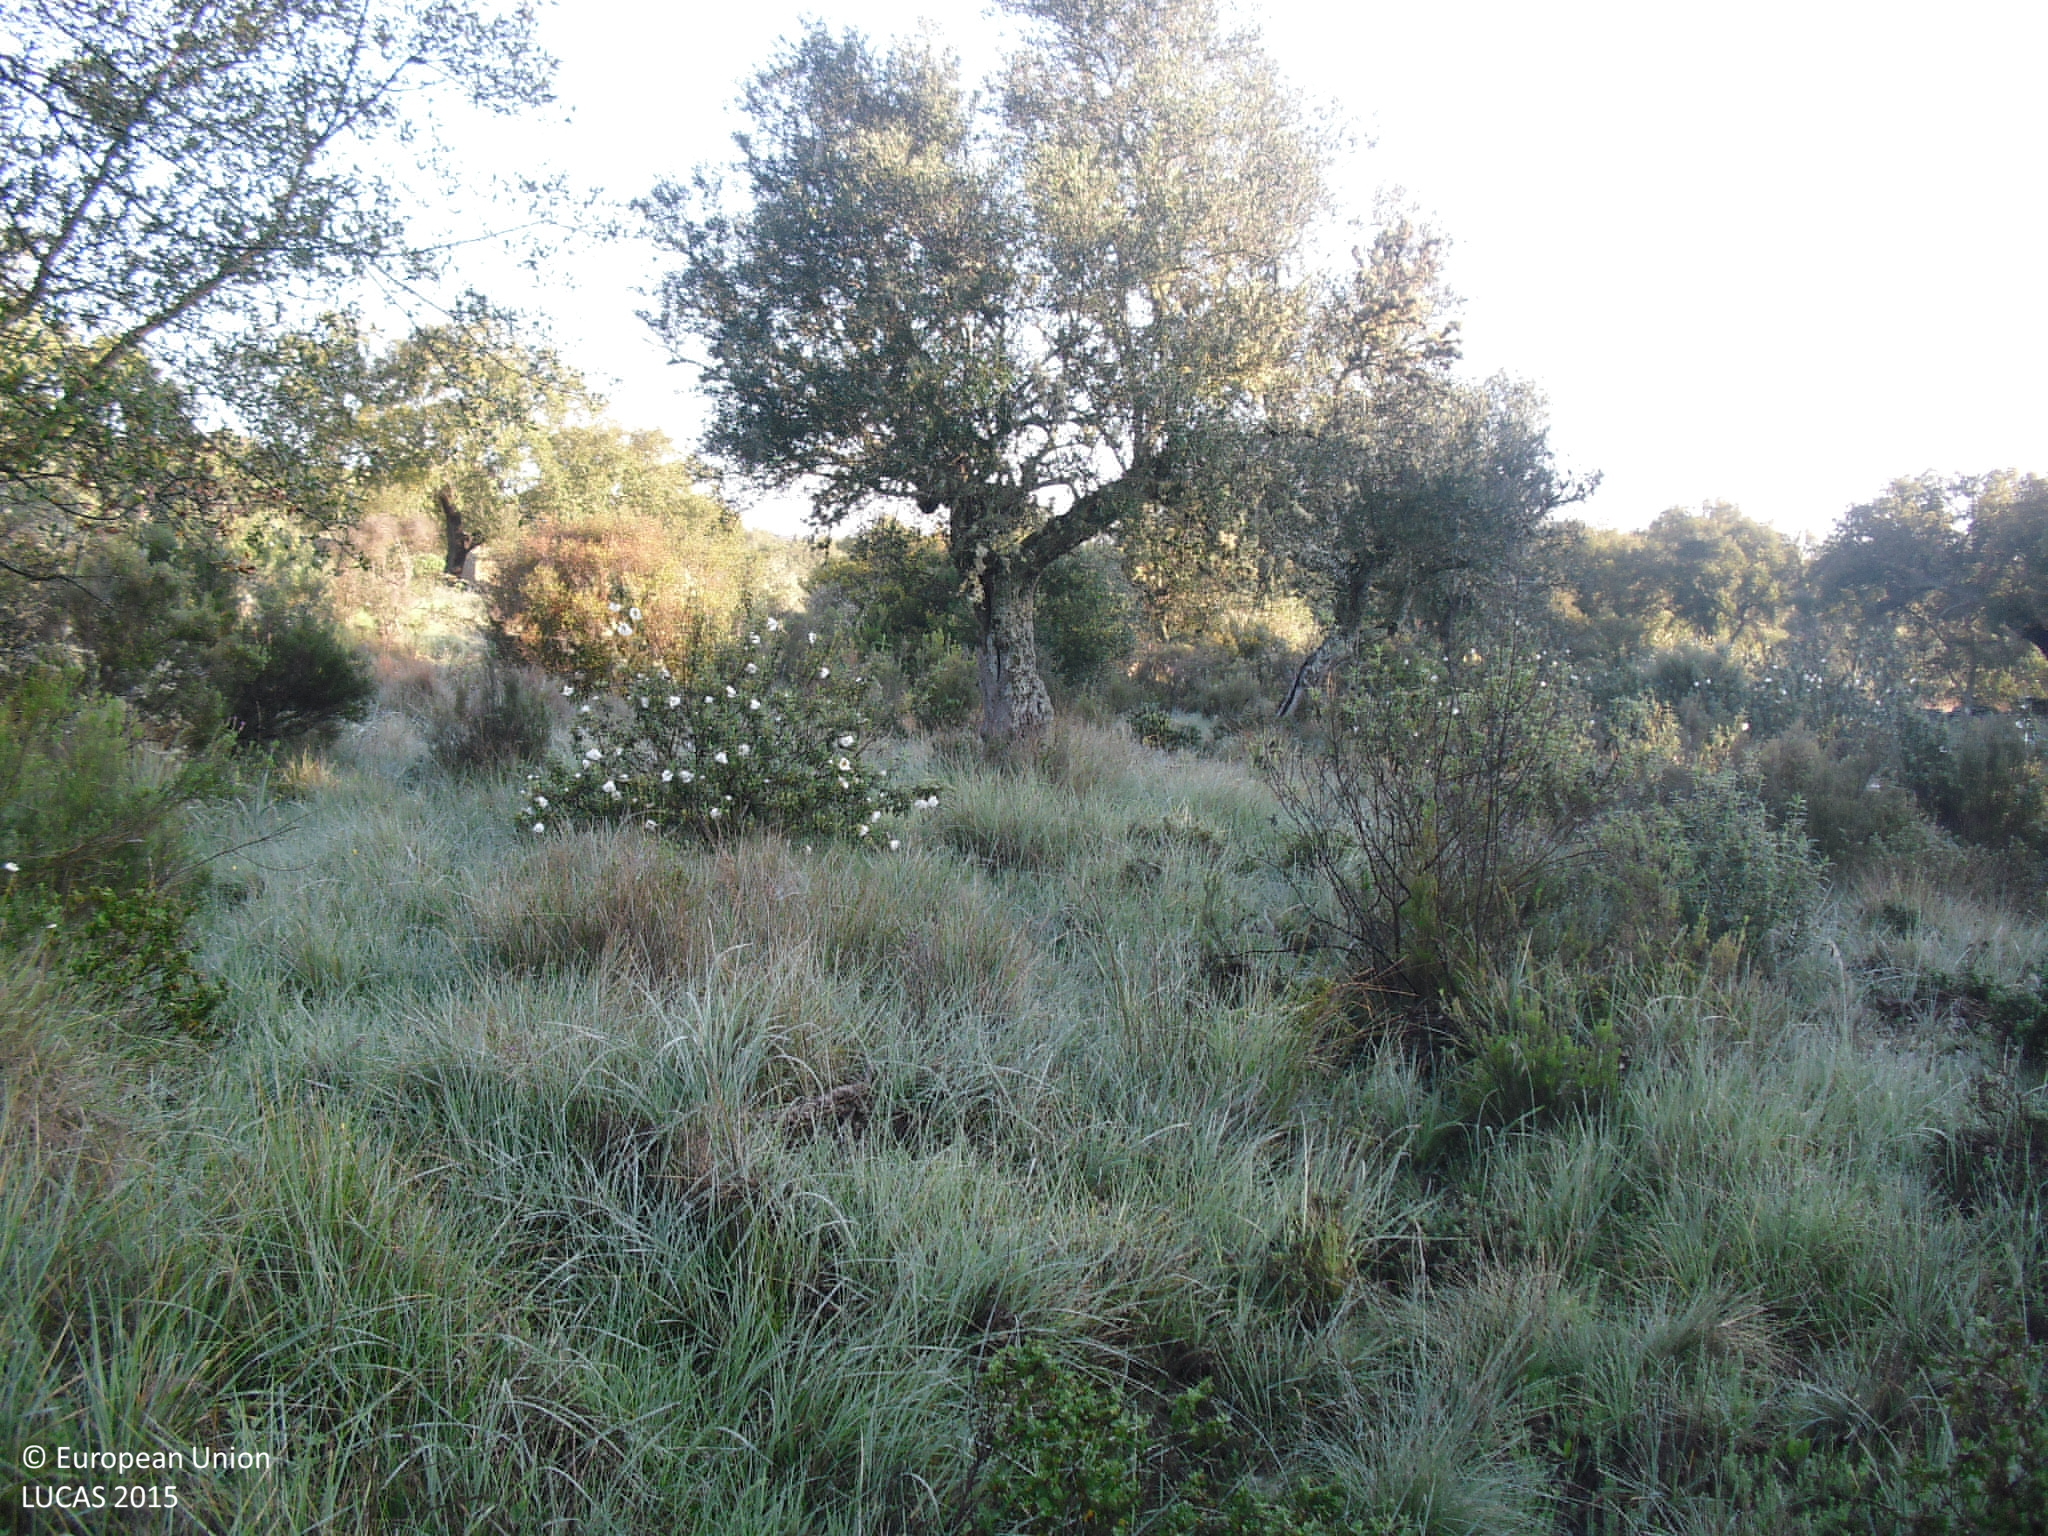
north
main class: Woodland
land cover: Broadleaved woodland
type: broadleaved evergreen forest
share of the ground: 25 - 50 %
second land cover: Grassland without tree/shrub cover
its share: > 75 %
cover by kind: herbaceous plants 60 %, broadleaved forest trees 30 %, shrubs 10 %
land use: Forestry
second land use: Agriculture (excluding fallow land and kitchen gardens)
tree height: > 5 m
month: April
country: ES
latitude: 39.6418
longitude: -7.4931
